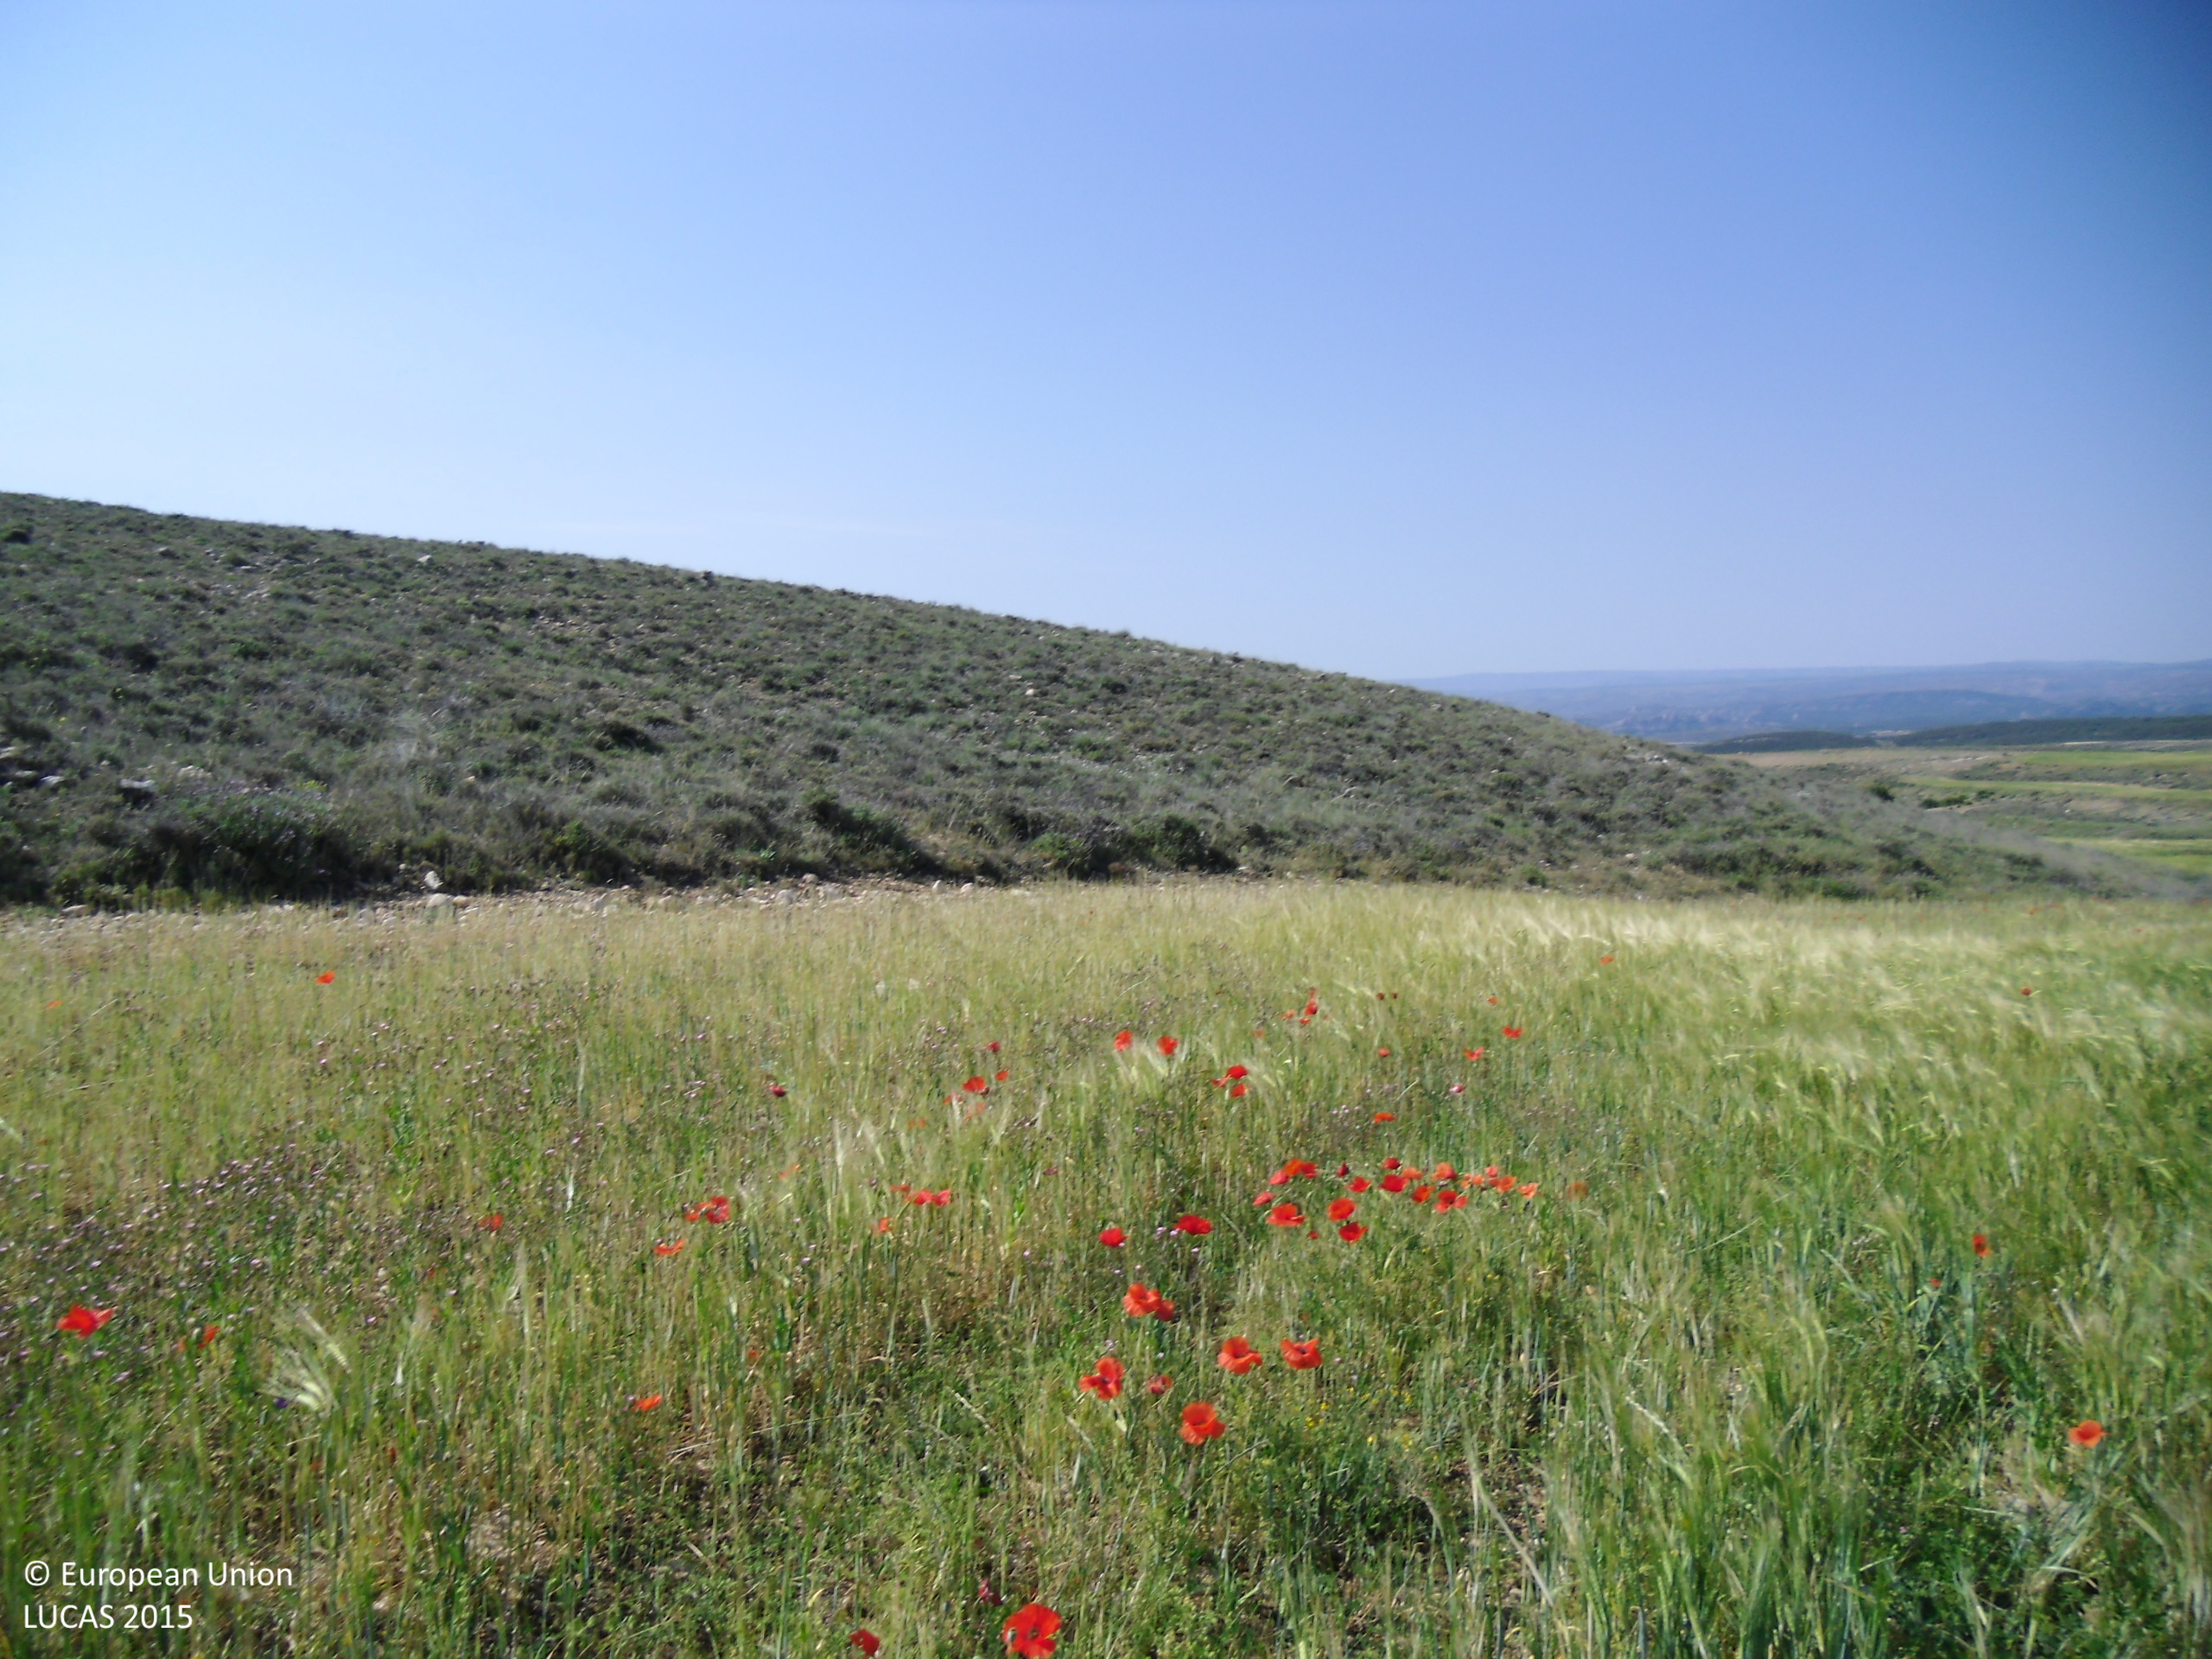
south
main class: Cropland
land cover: Barley
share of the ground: > 75 %
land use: Agriculture (excluding fallow land and kitchen gardens)
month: June
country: ES
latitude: 41.0669
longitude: -0.6897
